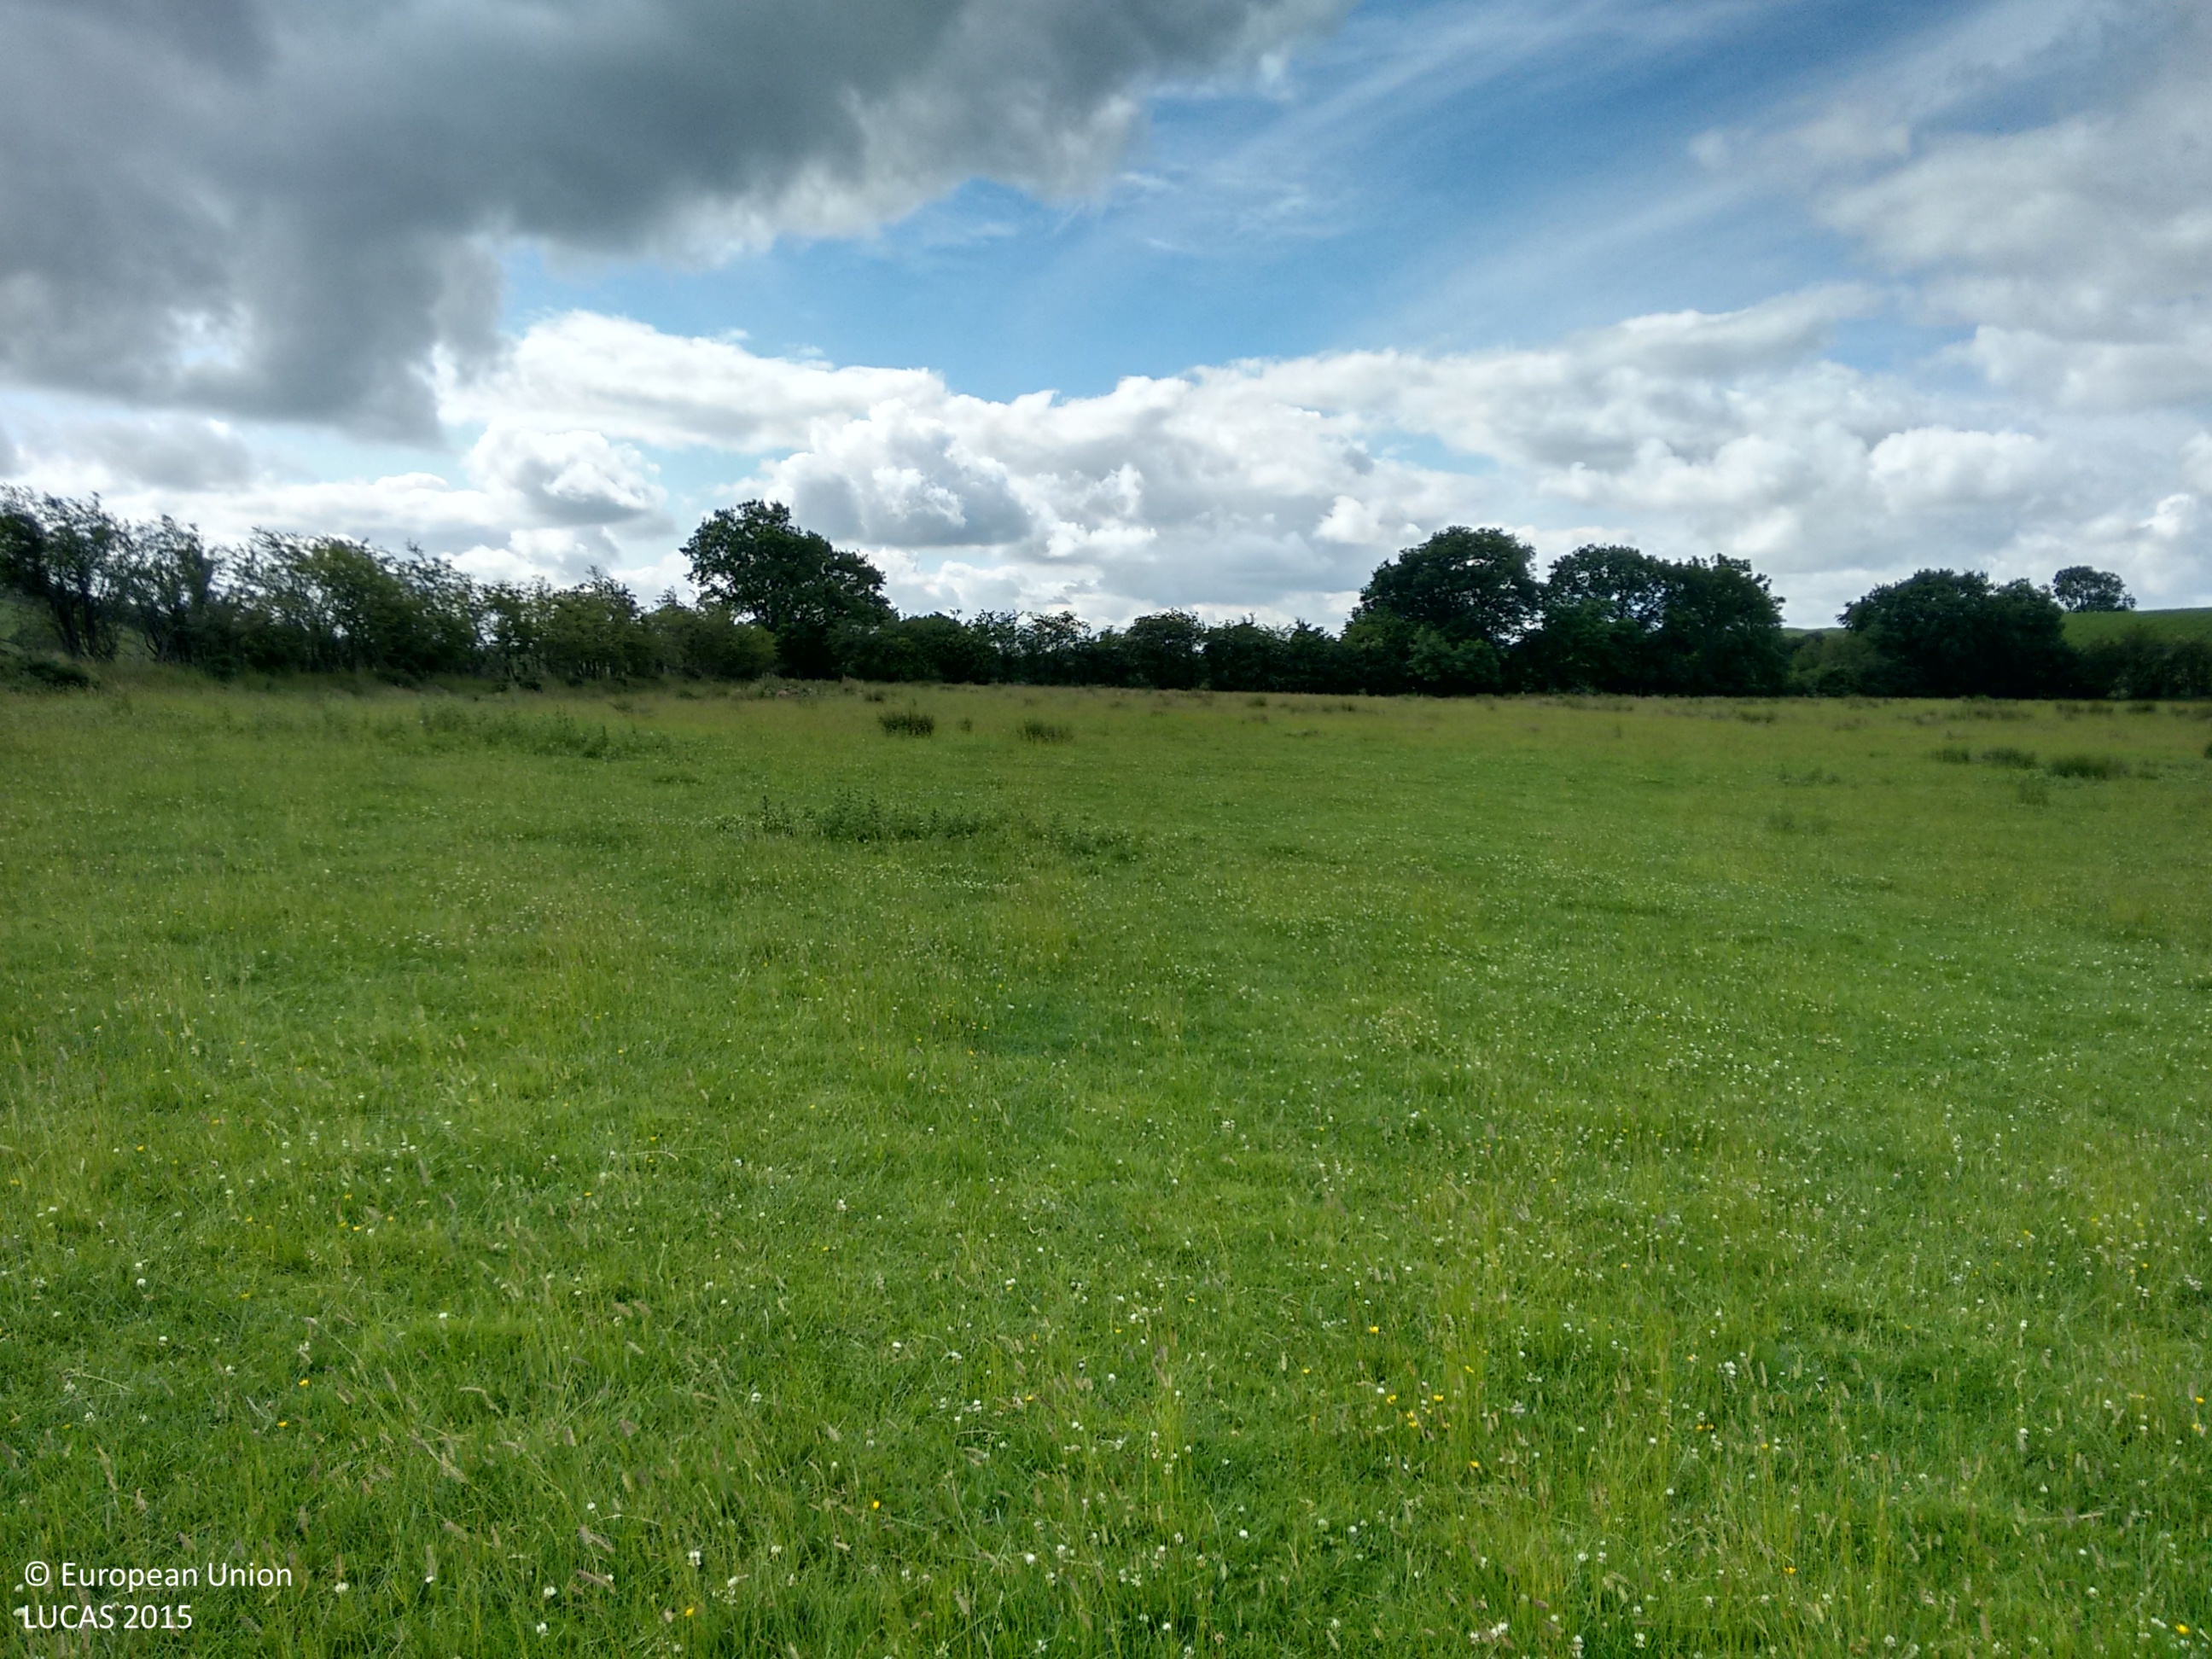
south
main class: Grassland
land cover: Grassland without tree/shrub cover
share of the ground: > 75 %
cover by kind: herbaceous plants 100 %
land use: Agriculture (excluding fallow land and kitchen gardens)
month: July
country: IE
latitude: 53.8463
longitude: -6.7153
